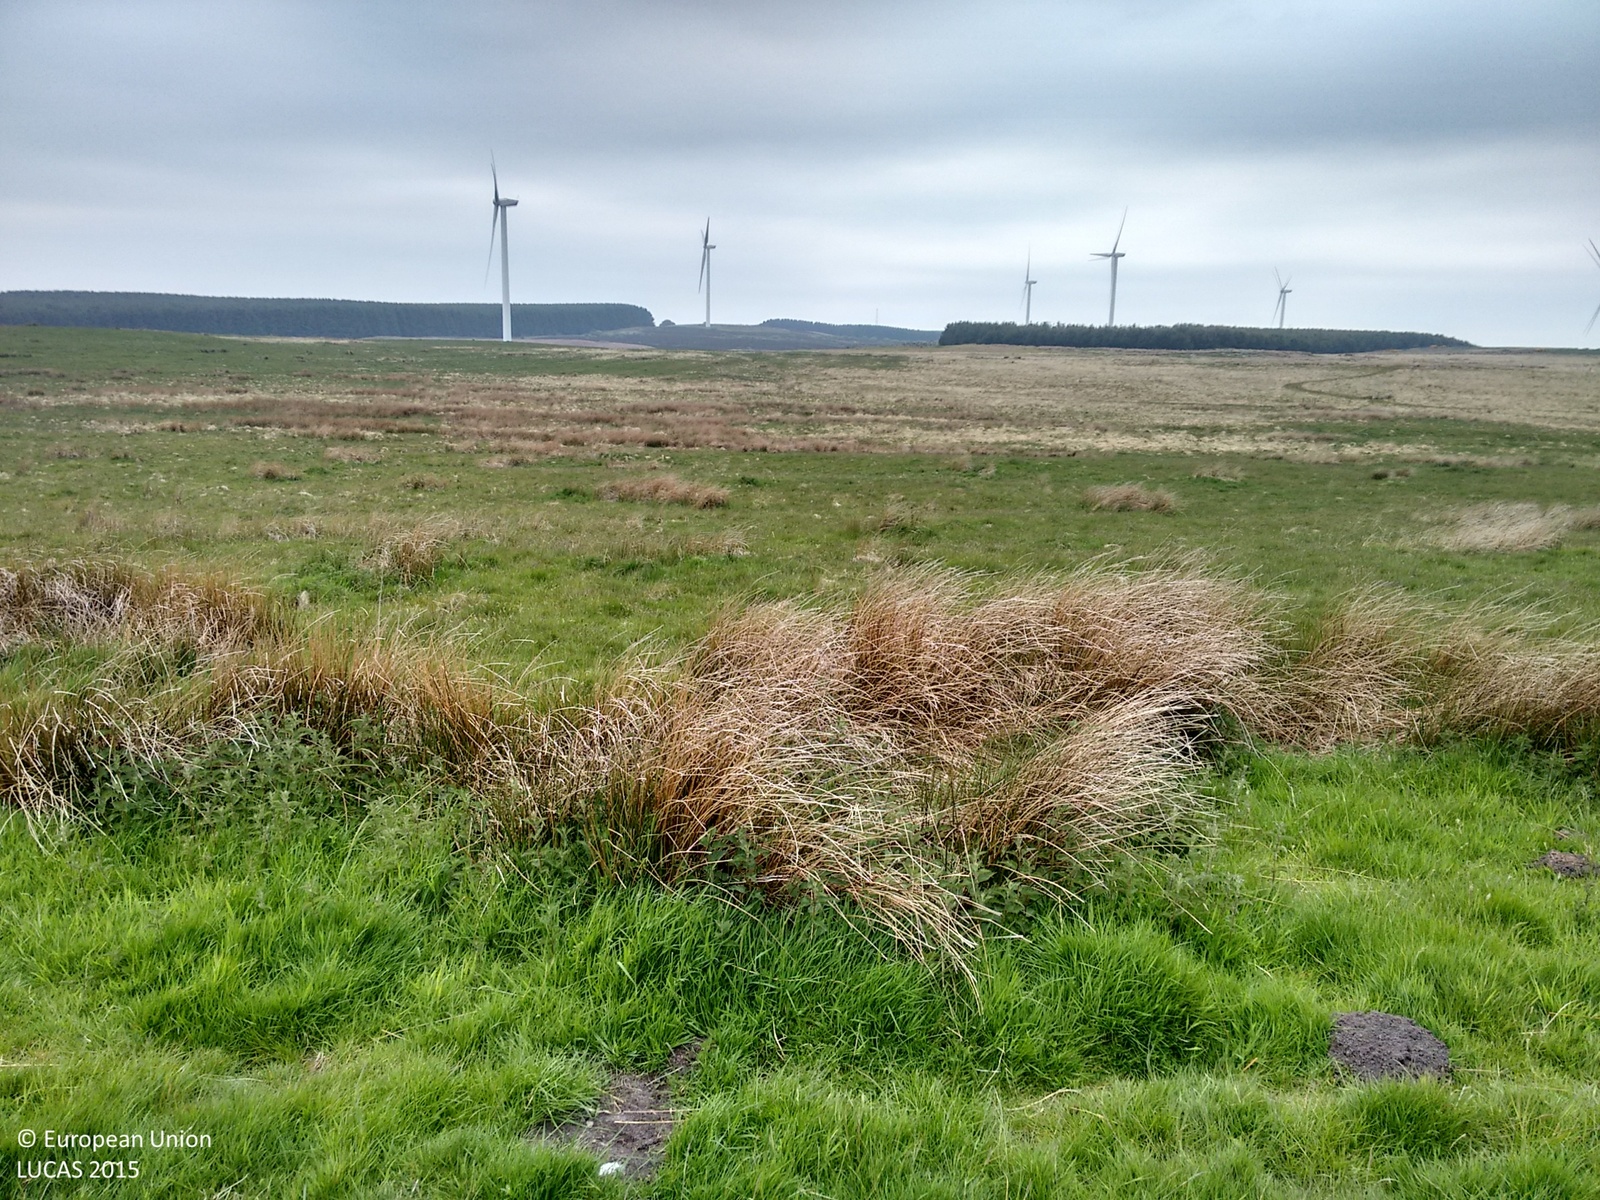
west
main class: Grassland
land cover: Grassland without tree/shrub cover
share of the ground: > 75 %
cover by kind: herbaceous plants 100 %
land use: Agriculture (excluding fallow land and kitchen gardens)
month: June
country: GB
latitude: 55.5152
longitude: -1.7849
